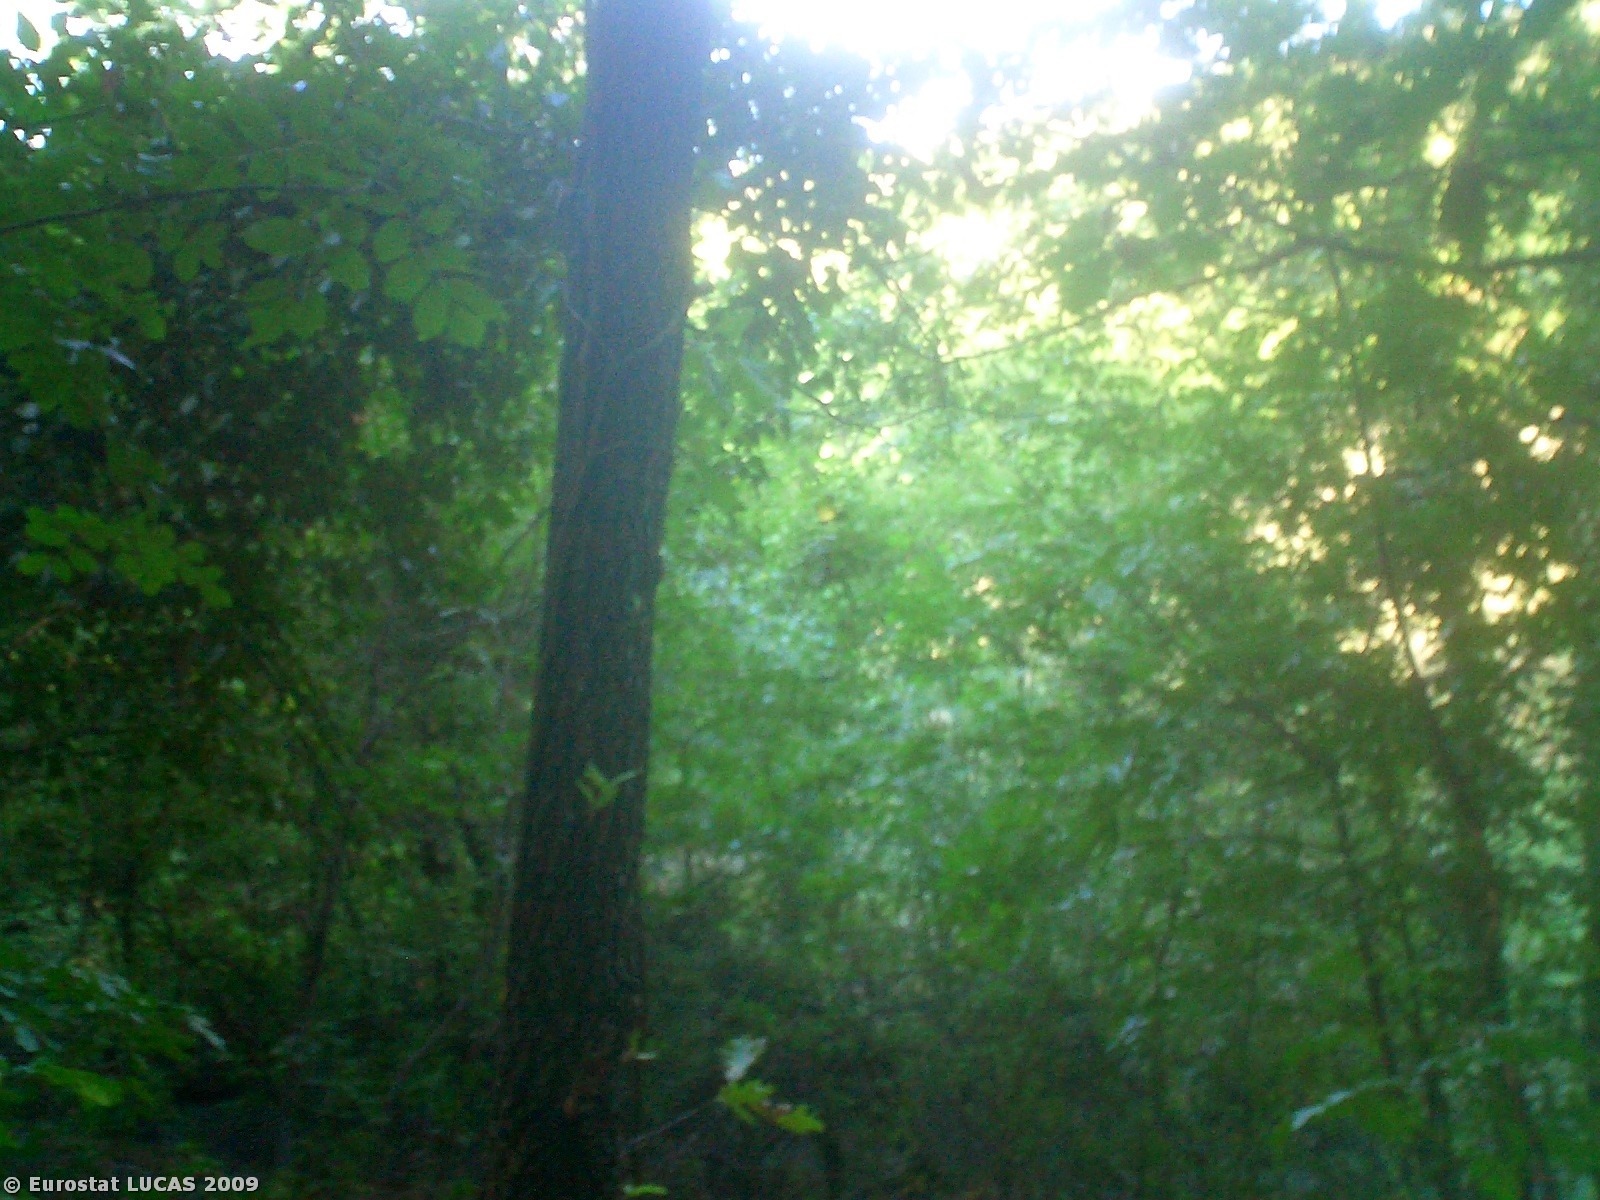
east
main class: Woodland
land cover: Mixed woodland
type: mesophytic deciduous forest
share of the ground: > 75 %
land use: Forestry
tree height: > 5 m
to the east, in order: Mixed woodland; Tracks; Mixed woodland
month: July
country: IT
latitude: 44.2655
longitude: 11.6373
